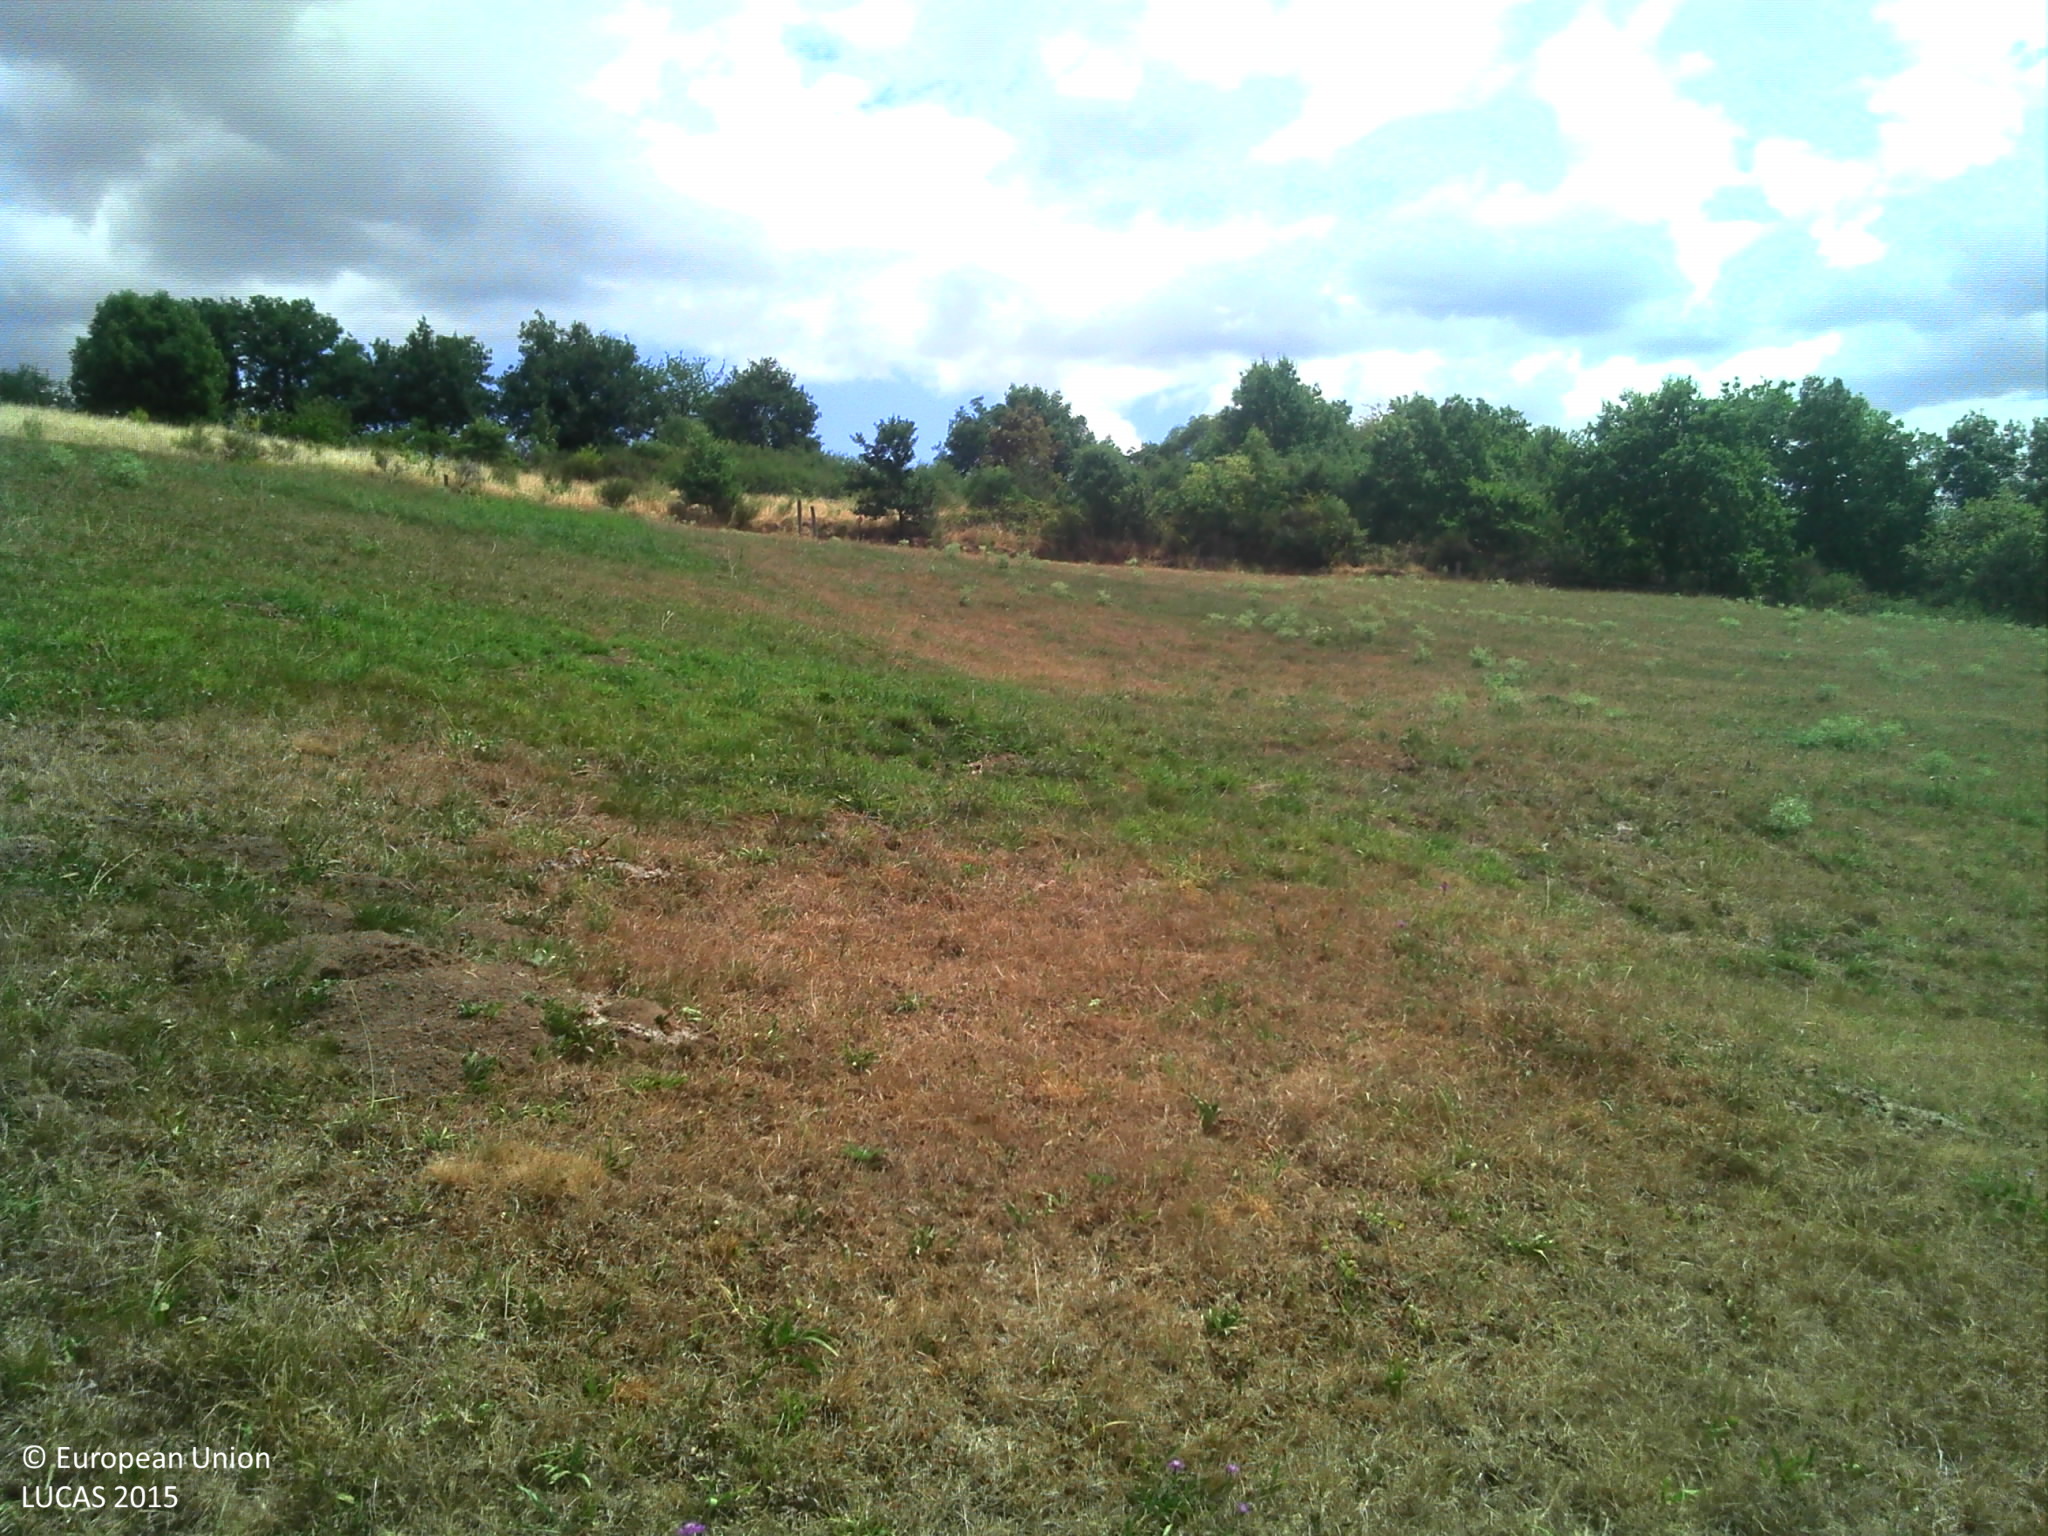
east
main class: Grassland
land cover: Grassland without tree/shrub cover
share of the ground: > 75 %
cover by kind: herbaceous plants 100 %
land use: Agriculture (excluding fallow land and kitchen gardens)
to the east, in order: Grassland without tree/shrub cover; Fences; Grass margins; Paved roads, cycling and walking lanes; Grass margins; Ditches and canals; Shrubland with sparse tree cover; Tracks; Grassland without tree/shrub cover; Shrubland with sparse tree cover; Tracks; Grassland without tree/shrub cover; Fences; Tracks; Fences; Grassland without tree/shrub cover; Fences; Maize
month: July
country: FR
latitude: 45.7398
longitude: 4.4895
